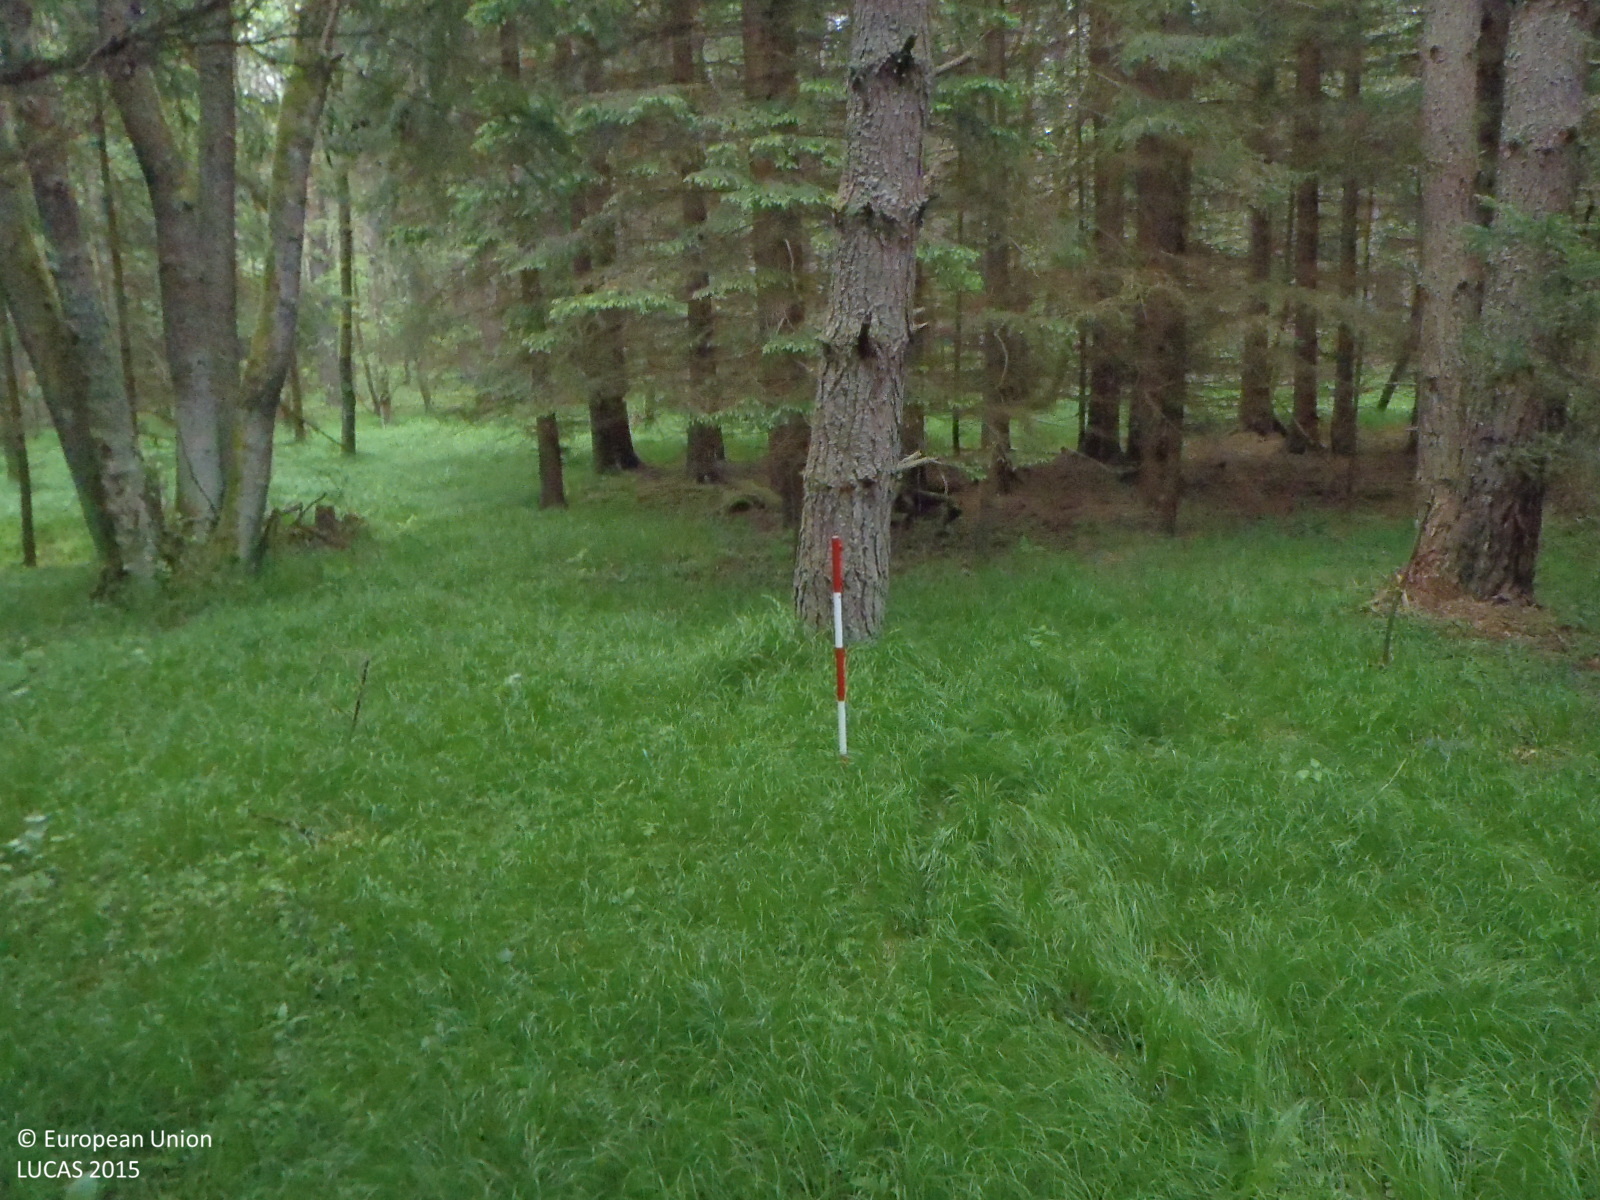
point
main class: Woodland
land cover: Other mixed woodland
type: hemiboreal forest and nemoral coniferous forest and mixed broadleaved-coniferous forest
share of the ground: > 75 %
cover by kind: coniferous forest trees 50 %, broadleaved forest trees 30 %, herbaceous plants 15 %, unconsolidated bare surface 5 %
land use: Forestry
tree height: > 5 m
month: May
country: CZ
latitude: 48.7106
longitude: 14.4448
